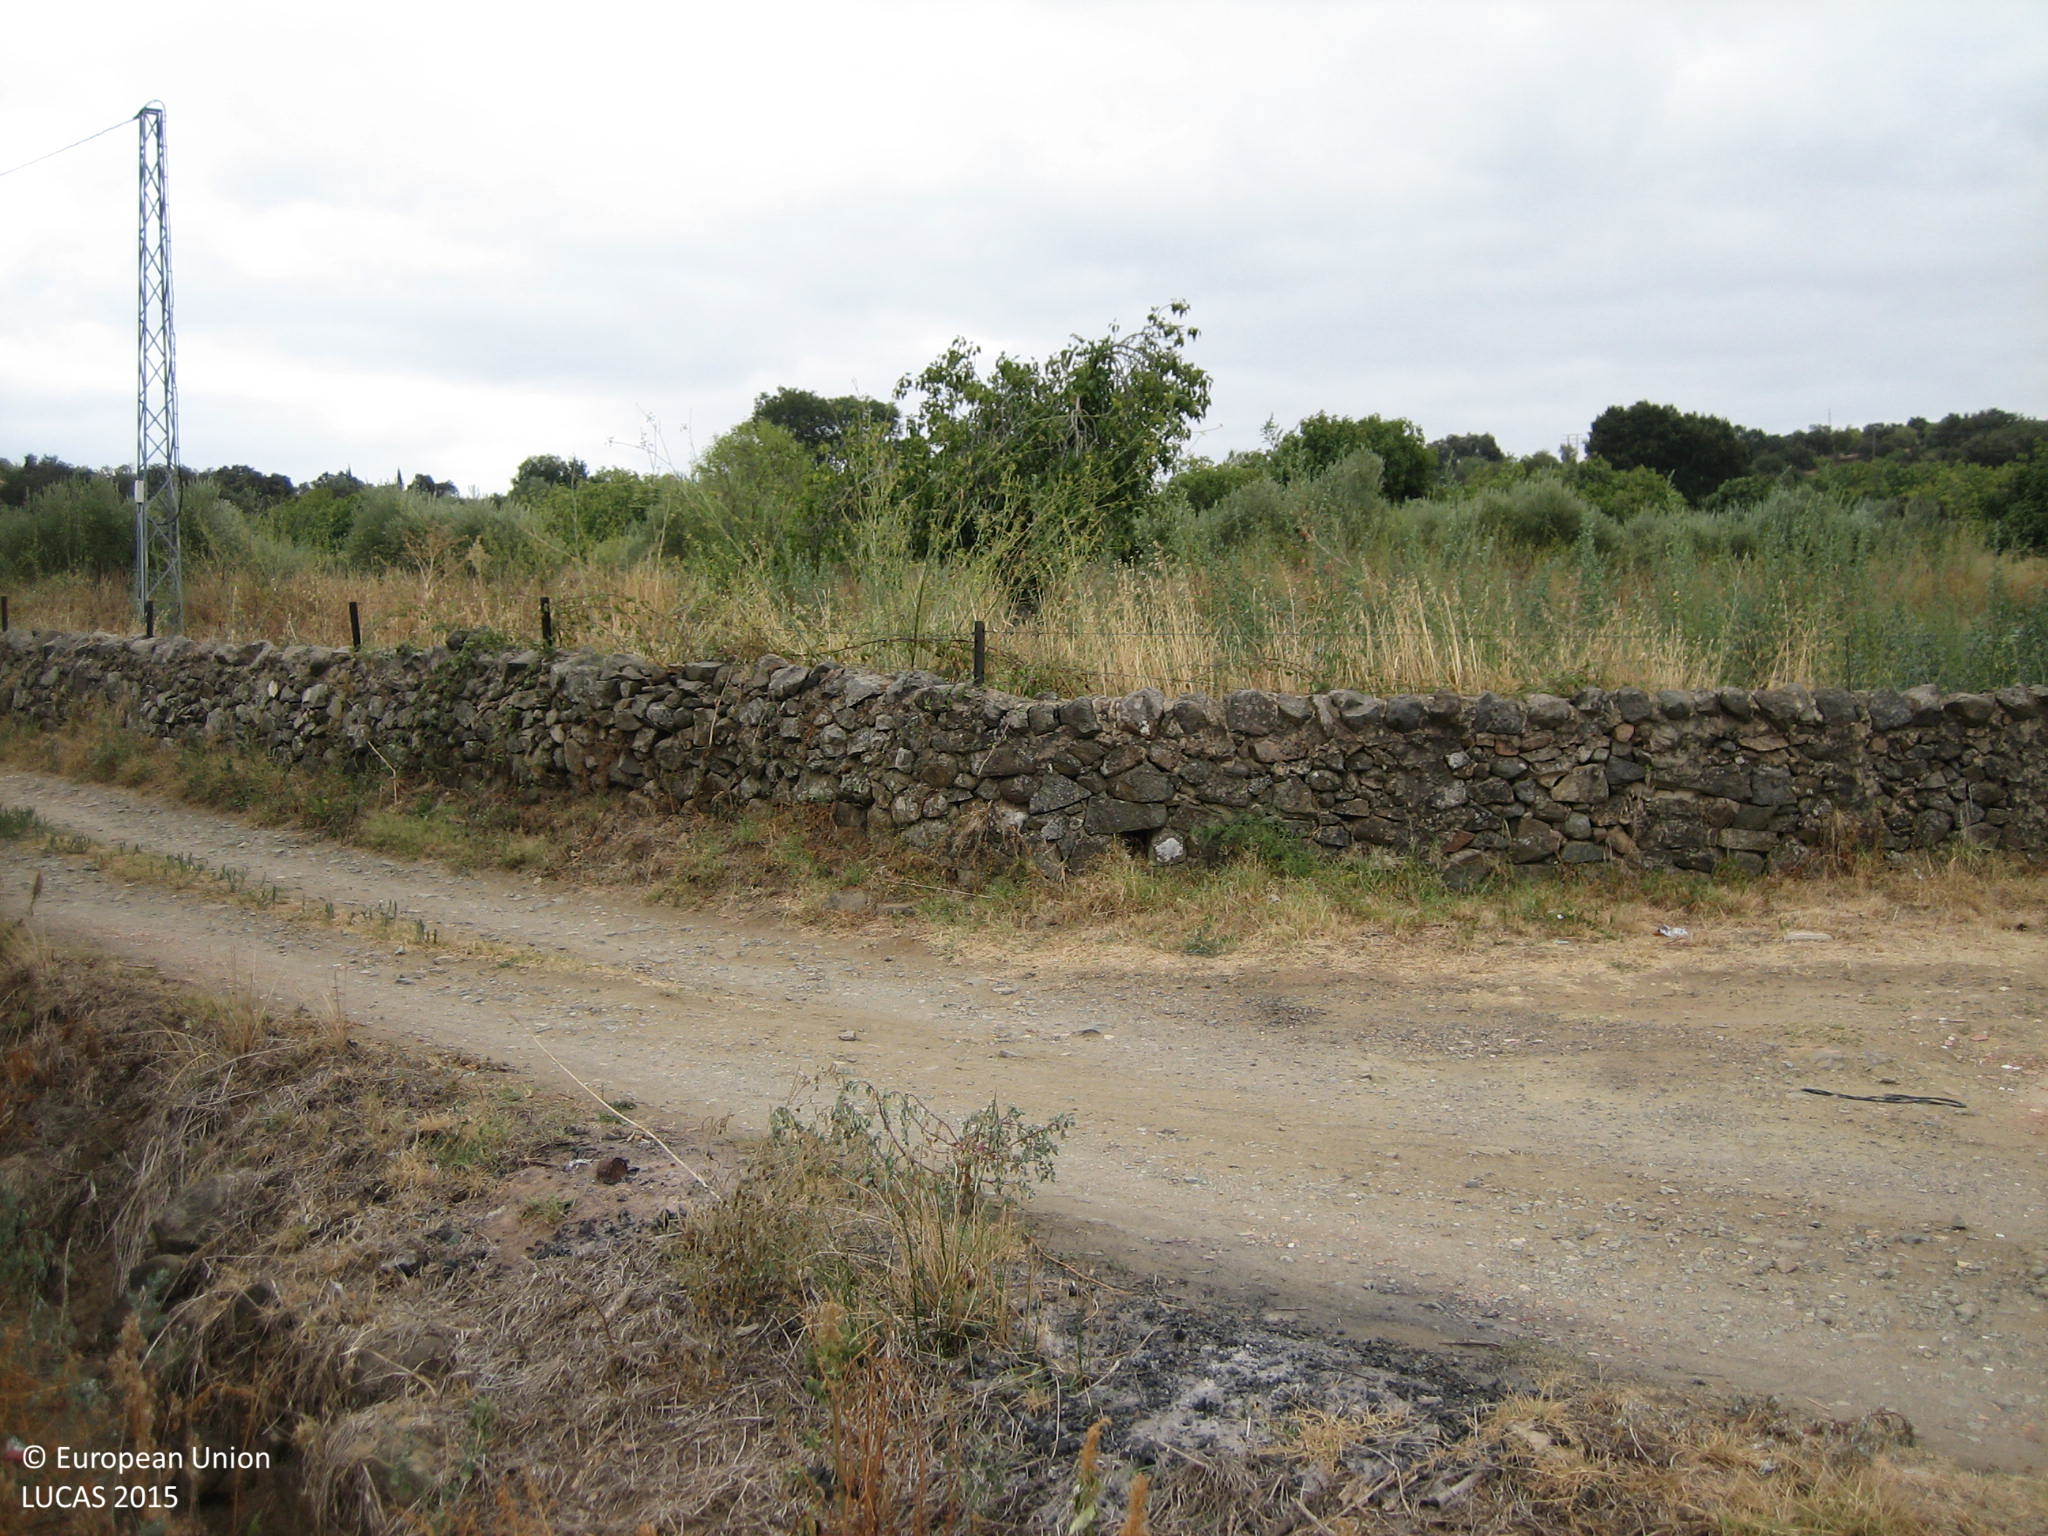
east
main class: Cropland
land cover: Other fruit trees and berries
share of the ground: 25 - 50 %
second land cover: Spontaneously vegetated surfaces
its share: 10 - 25 %
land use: Agriculture (excluding fallow land and kitchen gardens)
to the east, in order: Other fruit trees and berries; Spontaneously vegetated surfaces; Fences; Other fruit trees and berries; Grassland without tree/shrub cover; Other fruit trees and berries; Fences; Other fruit trees and berries; Fences; Olive groves; Oranges; Fences; Dry stone walls; Ditches and canals; Tracks; Dry stone walls; Other fruit trees and berries; Fences; Tracks; Dry stone walls; Single bushes/trees; Spontaneously vegetated surfaces; Fences; Spontaneously vegetated surfaces; Other fruit trees and berries
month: September
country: ES
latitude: 38.5190
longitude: -6.8636
